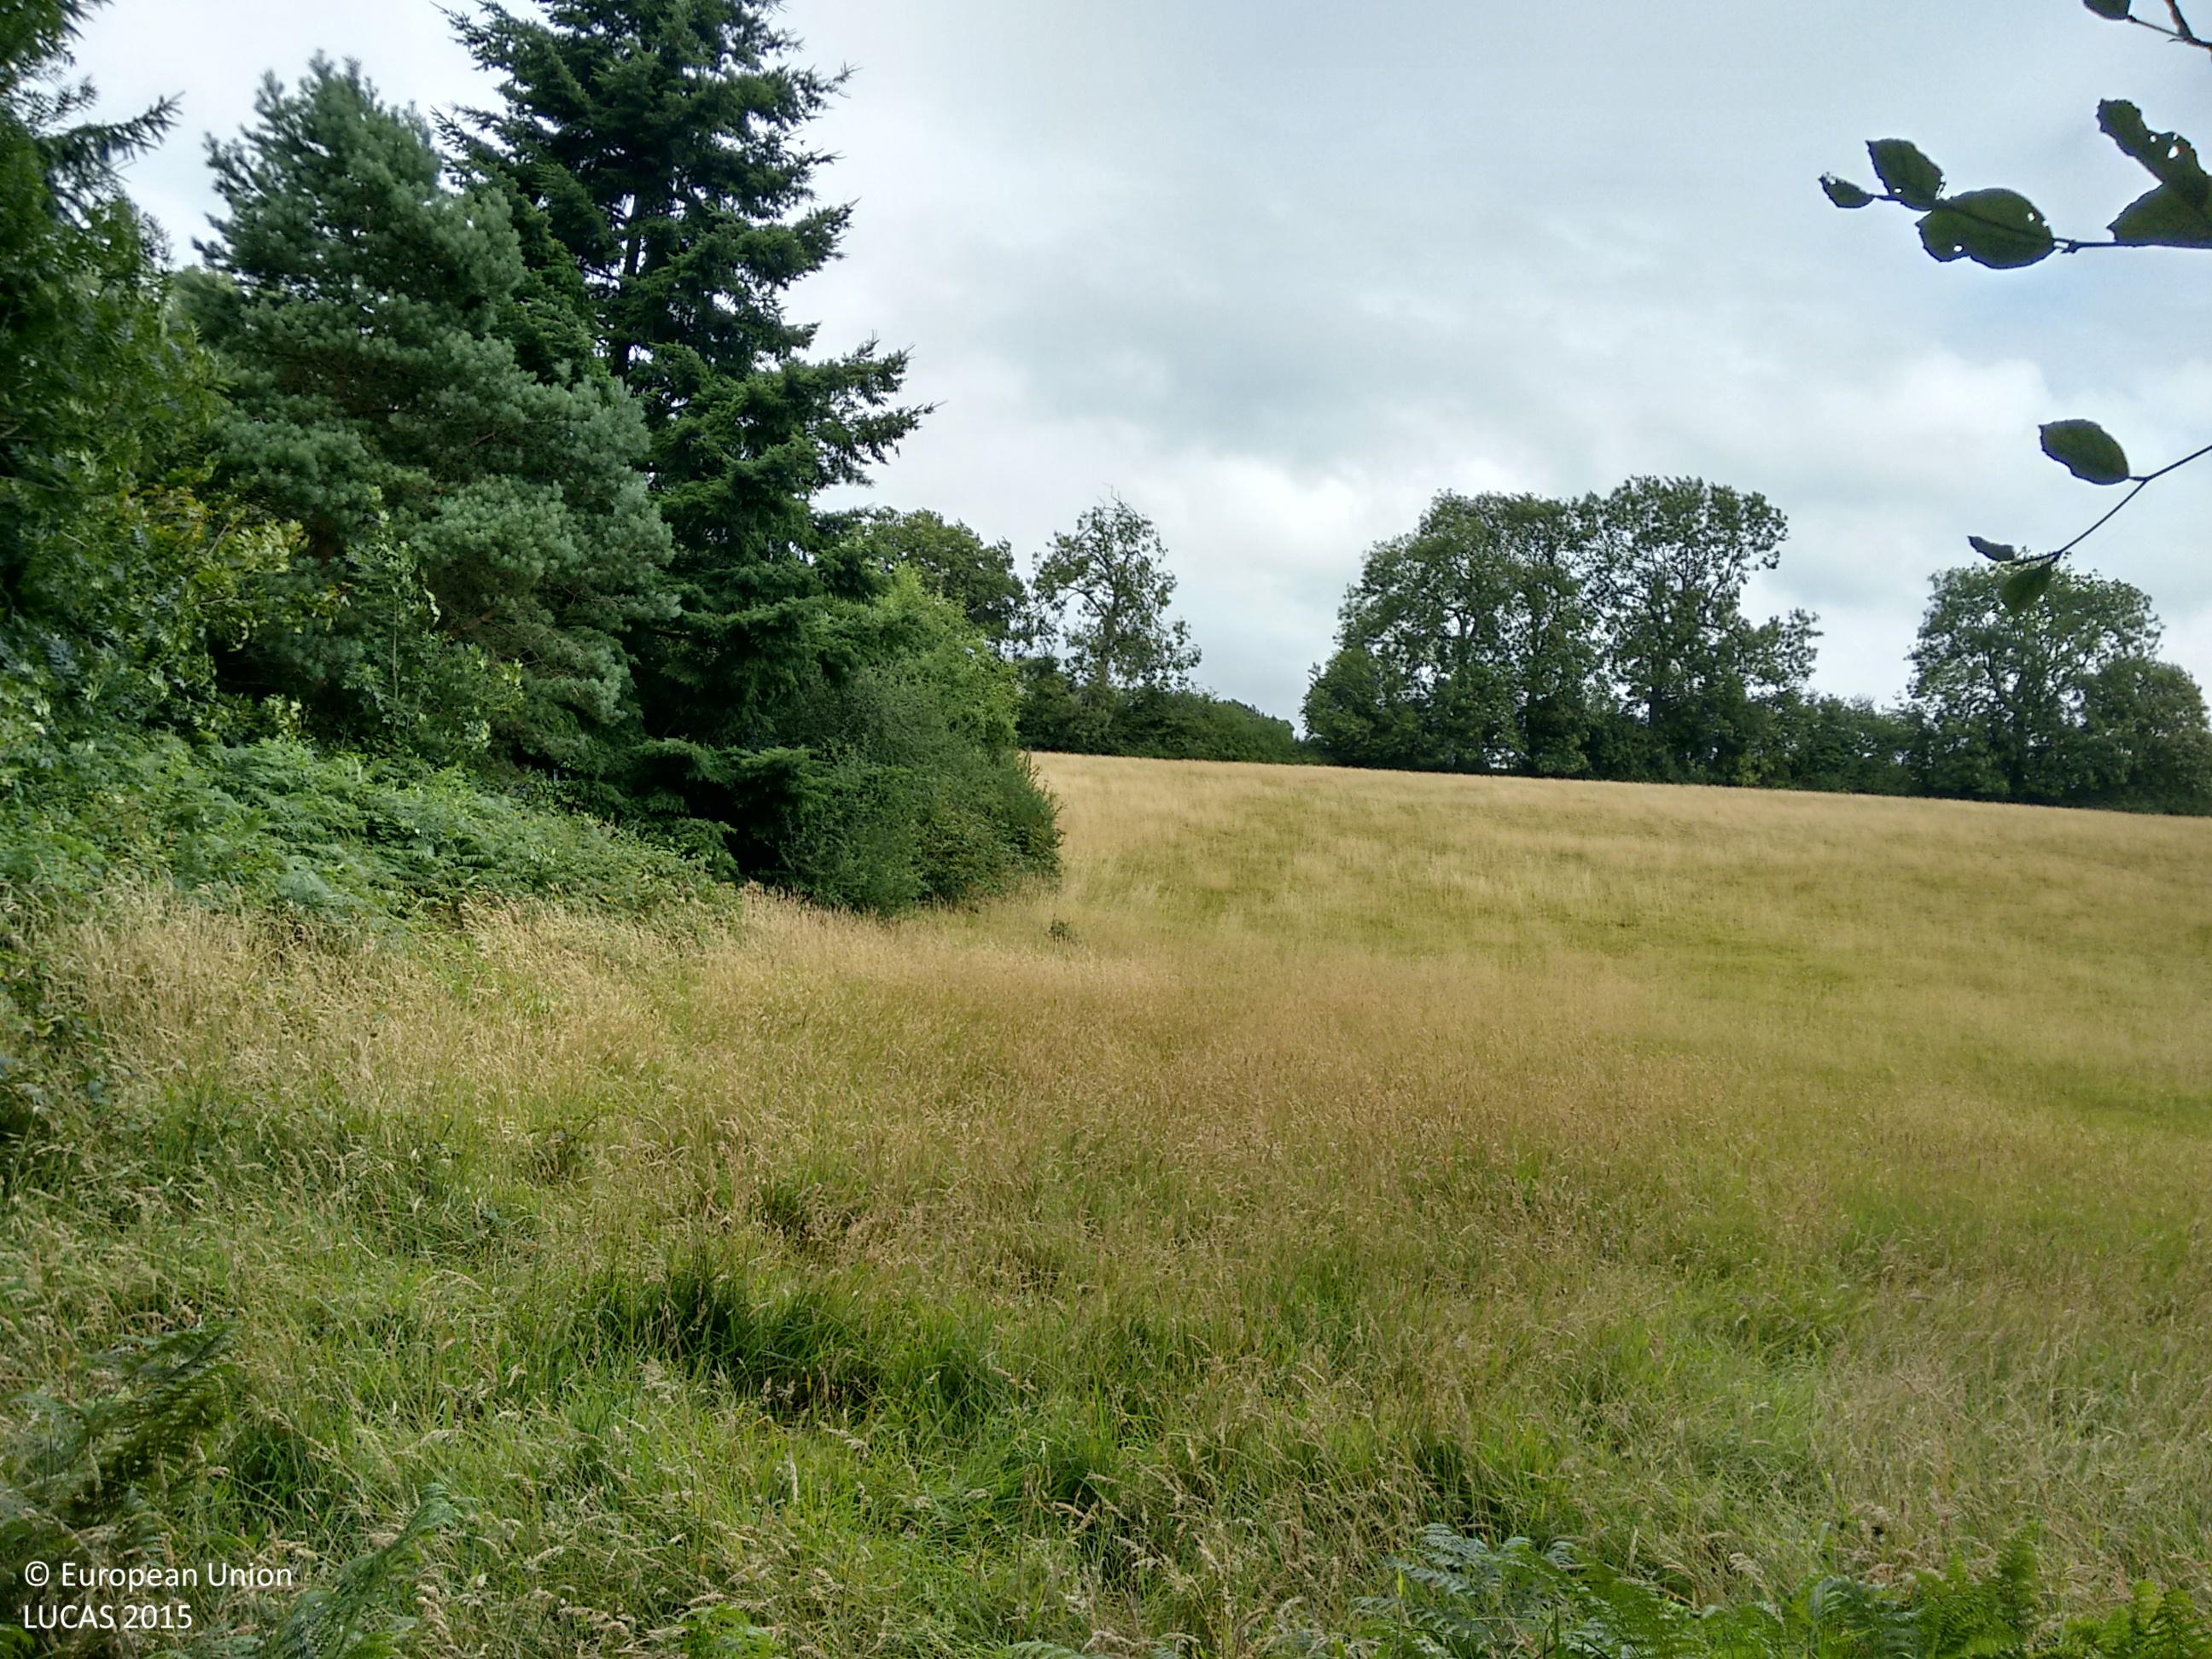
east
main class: Woodland
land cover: Broadleaved woodland
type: mesophytic deciduous forest
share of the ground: > 75 %
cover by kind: broadleaved forest trees 75 %, shrubs 25 %
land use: Forestry
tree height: > 5 m
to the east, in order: Broadleaved woodland; Fences; Grassland without tree/shrub cover; Abandoned hedges; Artificial constructions in urban areas; Grassland without tree/shrub cover
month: August
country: GB
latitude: 51.2741
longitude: -0.1112
